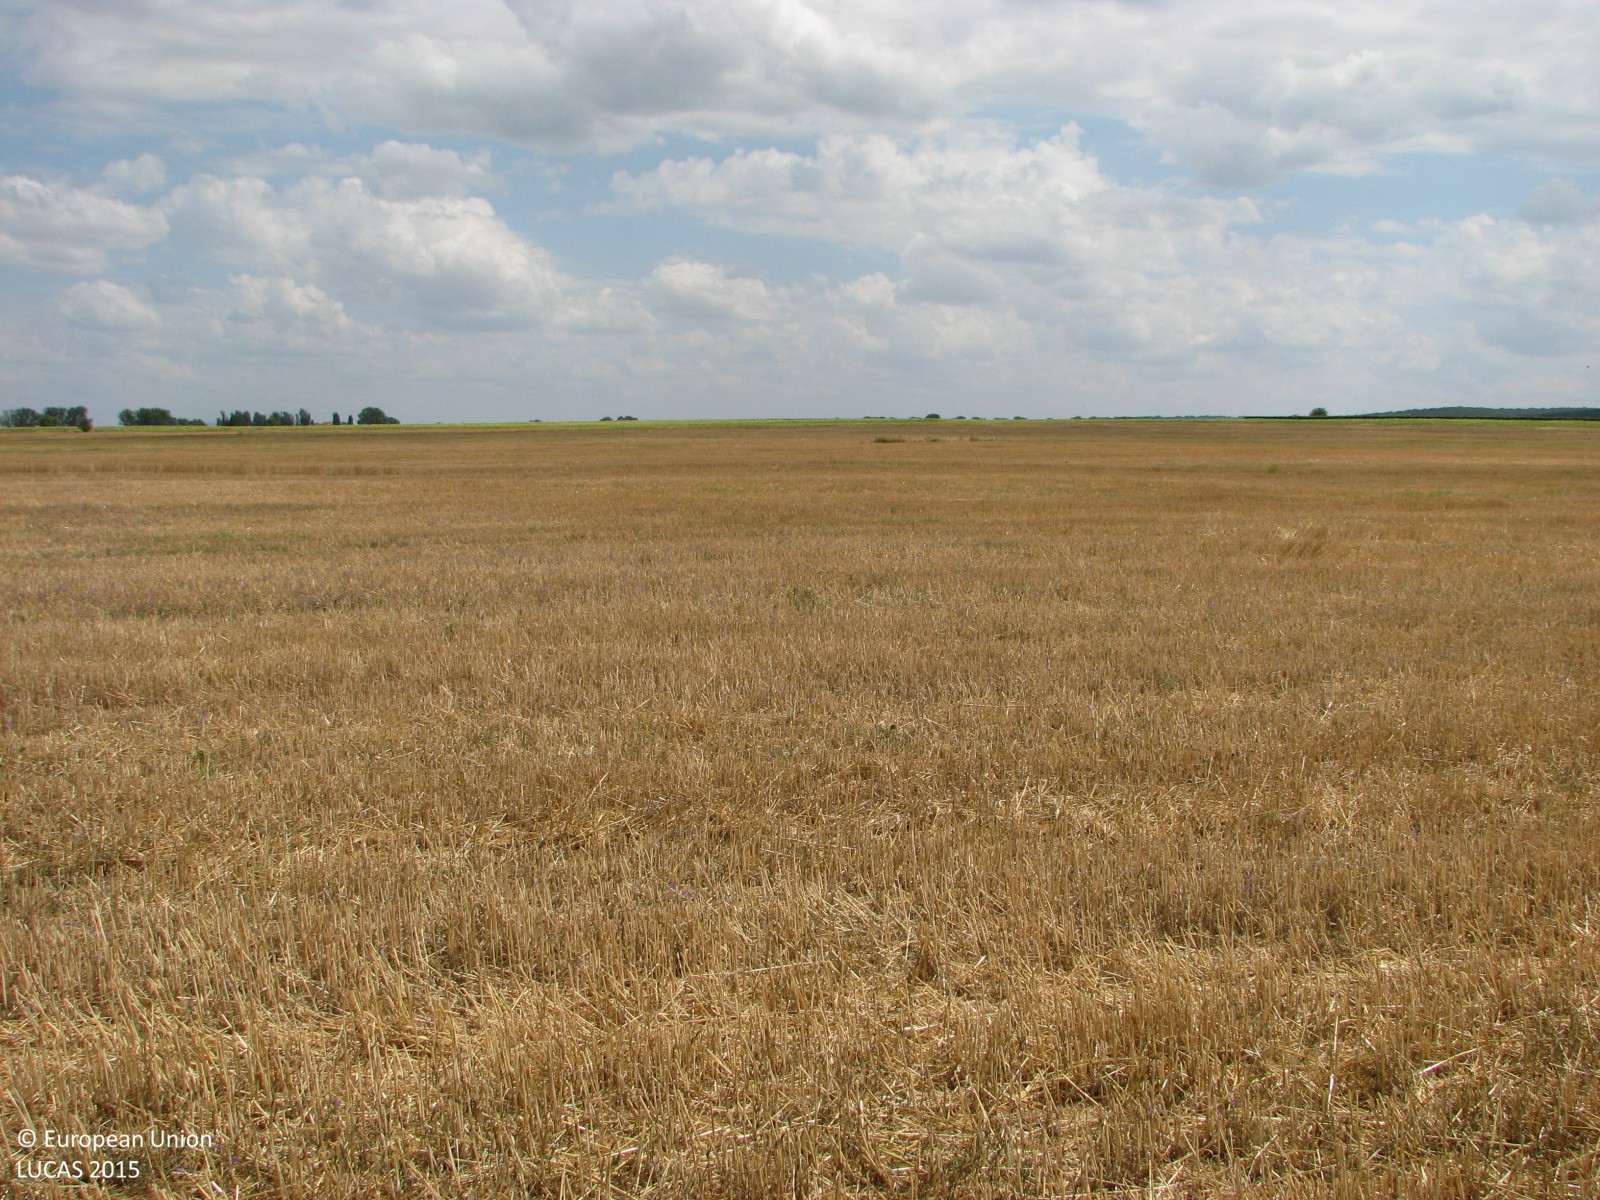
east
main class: Cropland
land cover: Common wheat
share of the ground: 50 - 75 %
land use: Agriculture (excluding fallow land and kitchen gardens)
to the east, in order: Common wheat
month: August
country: BG
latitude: 42.7189
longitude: 26.6448
